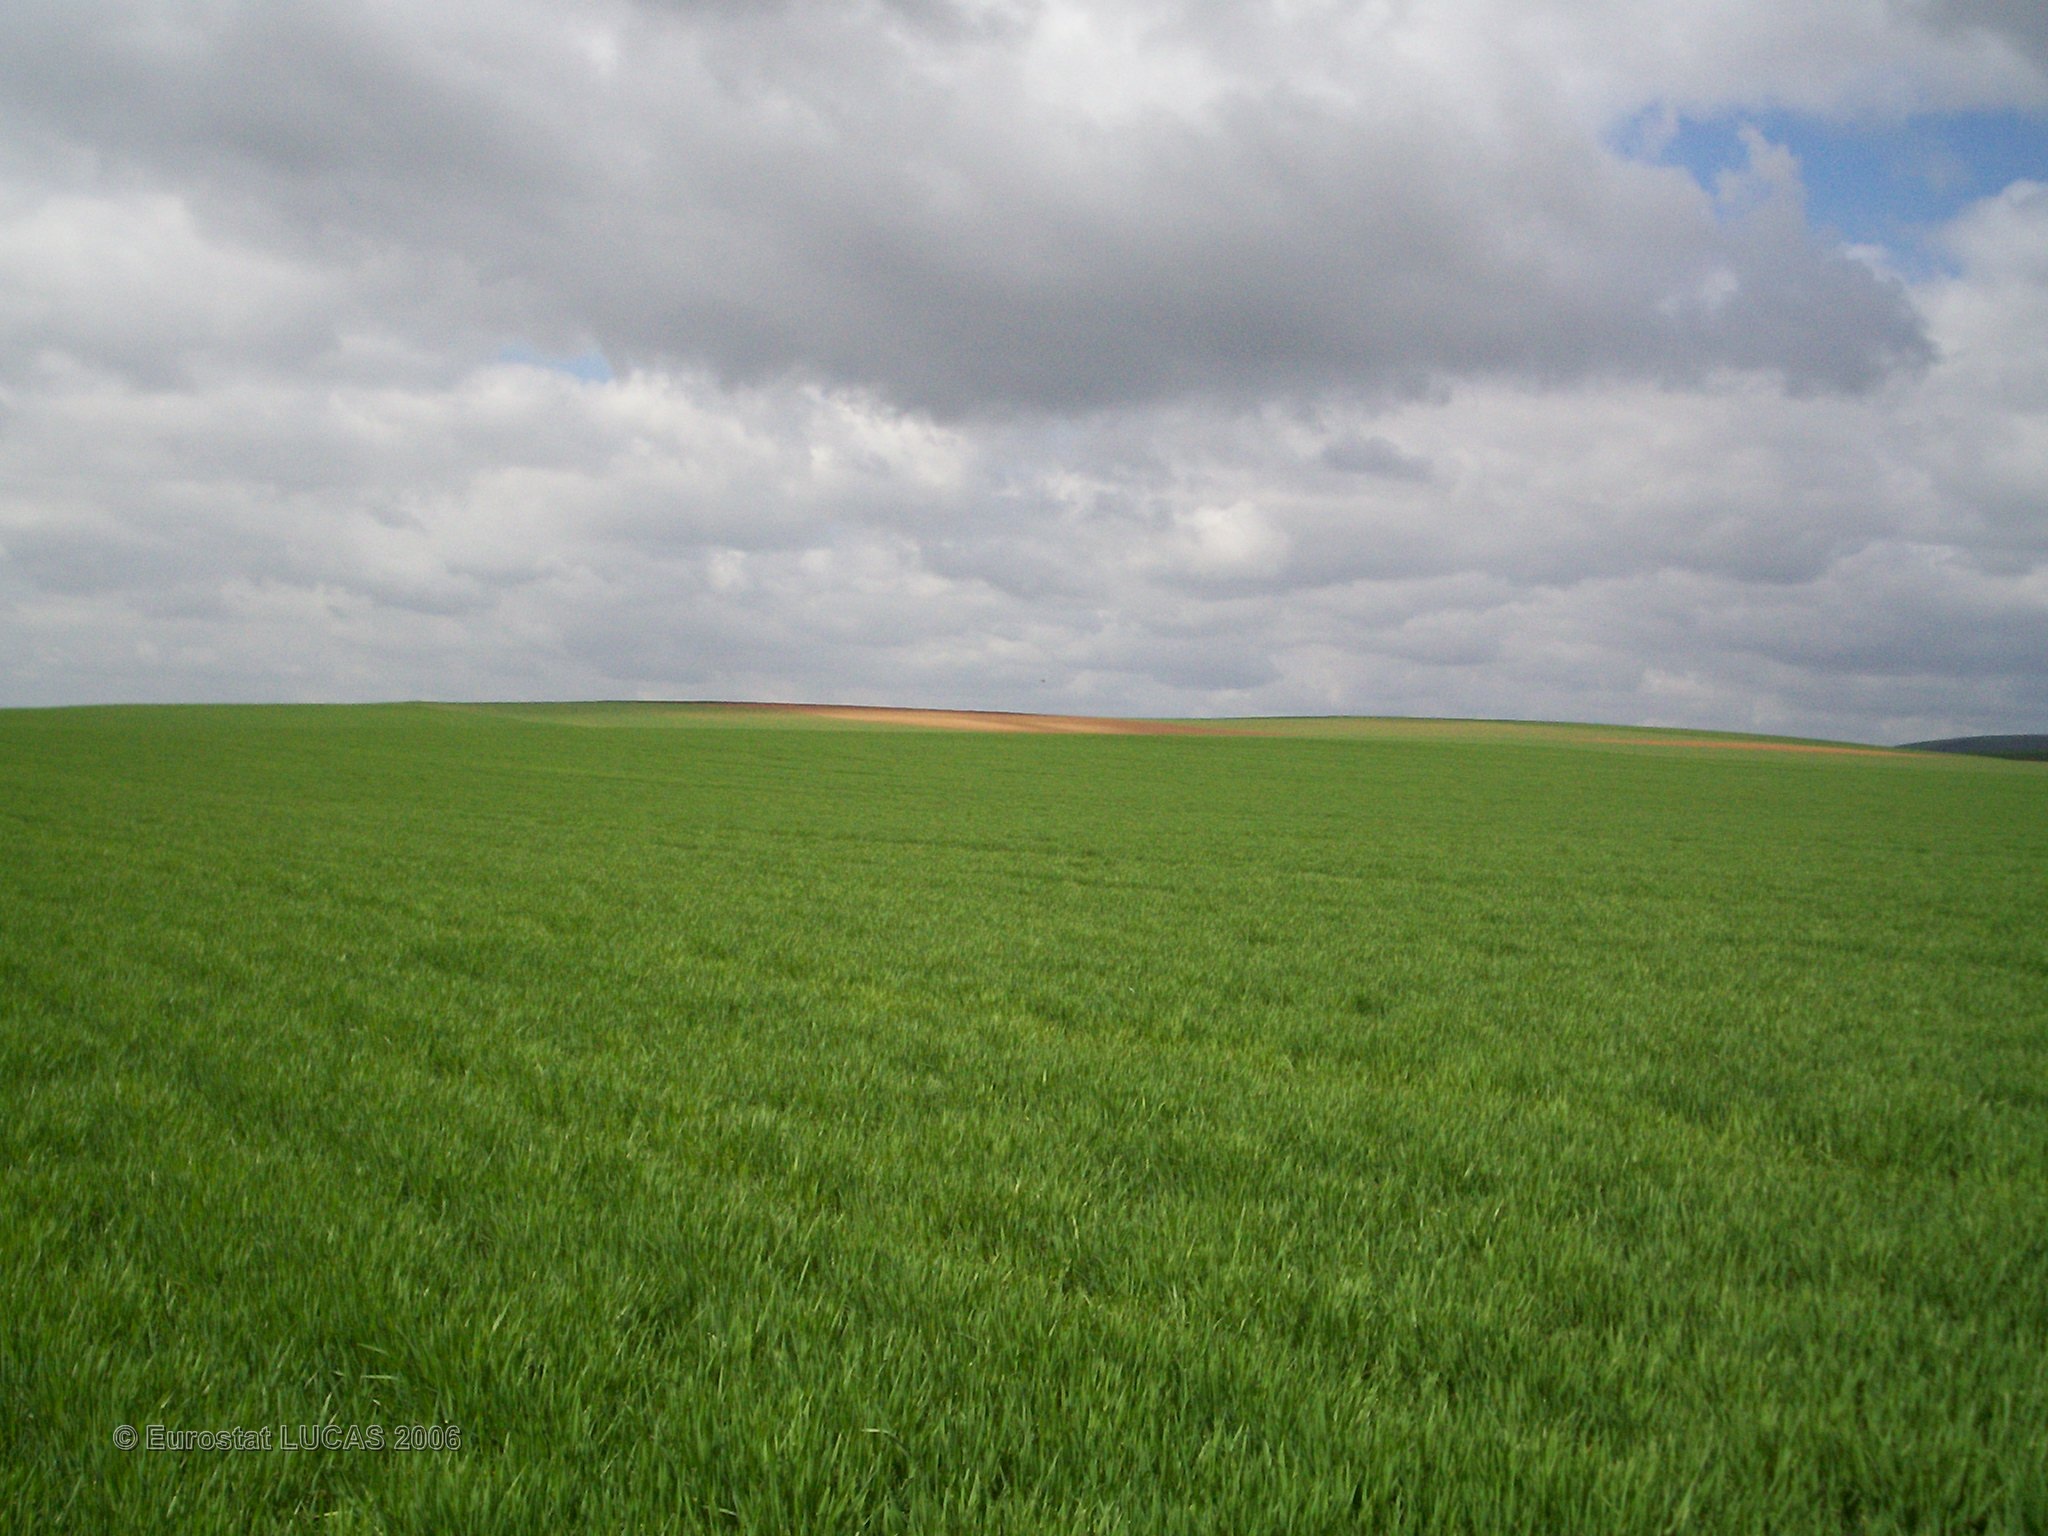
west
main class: Cropland
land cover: Barley
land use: Agriculture (excluding fallow land and kitchen gardens)
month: April
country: FR
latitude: 48.0676
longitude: 3.8093
